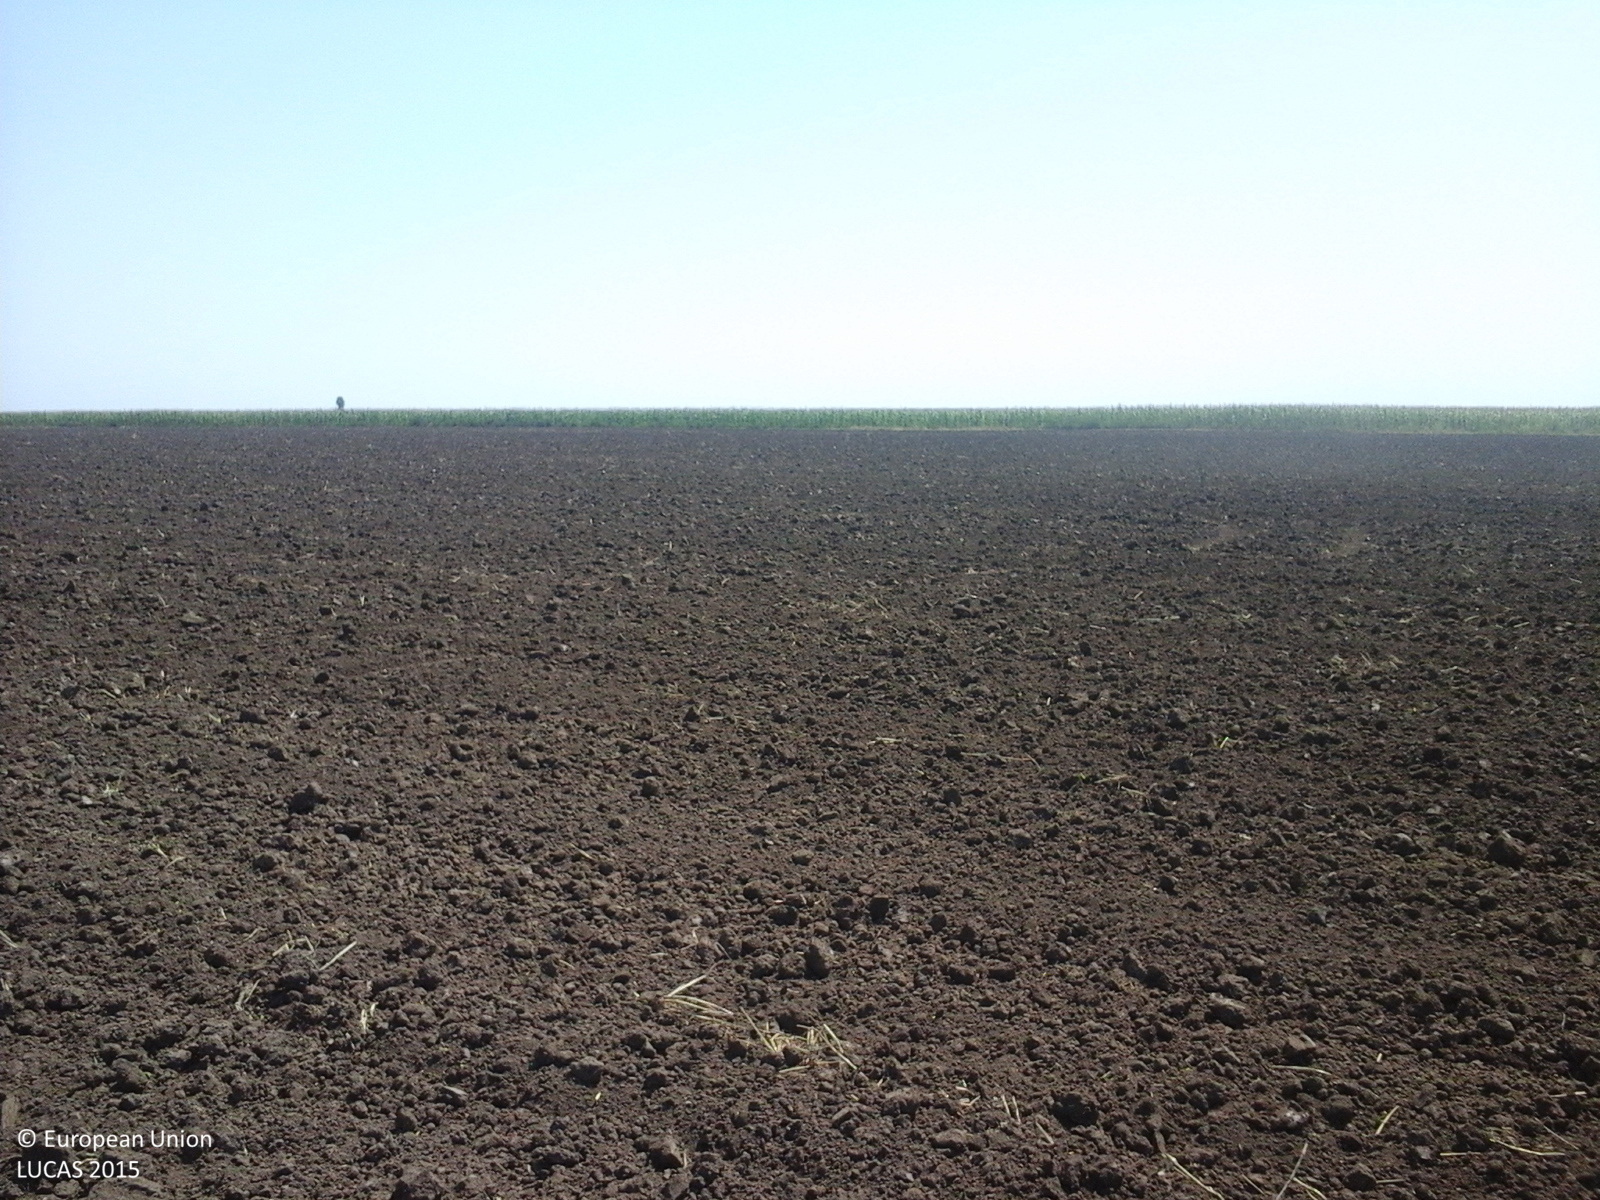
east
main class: Cropland
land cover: Common wheat
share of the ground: < 10 %
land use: Agriculture (excluding fallow land and kitchen gardens)
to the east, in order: Common wheat; Tracks; Grass margins; Maize; Common wheat; Maize; Lucerne
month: July
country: RO
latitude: 44.6848
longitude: 26.7662
